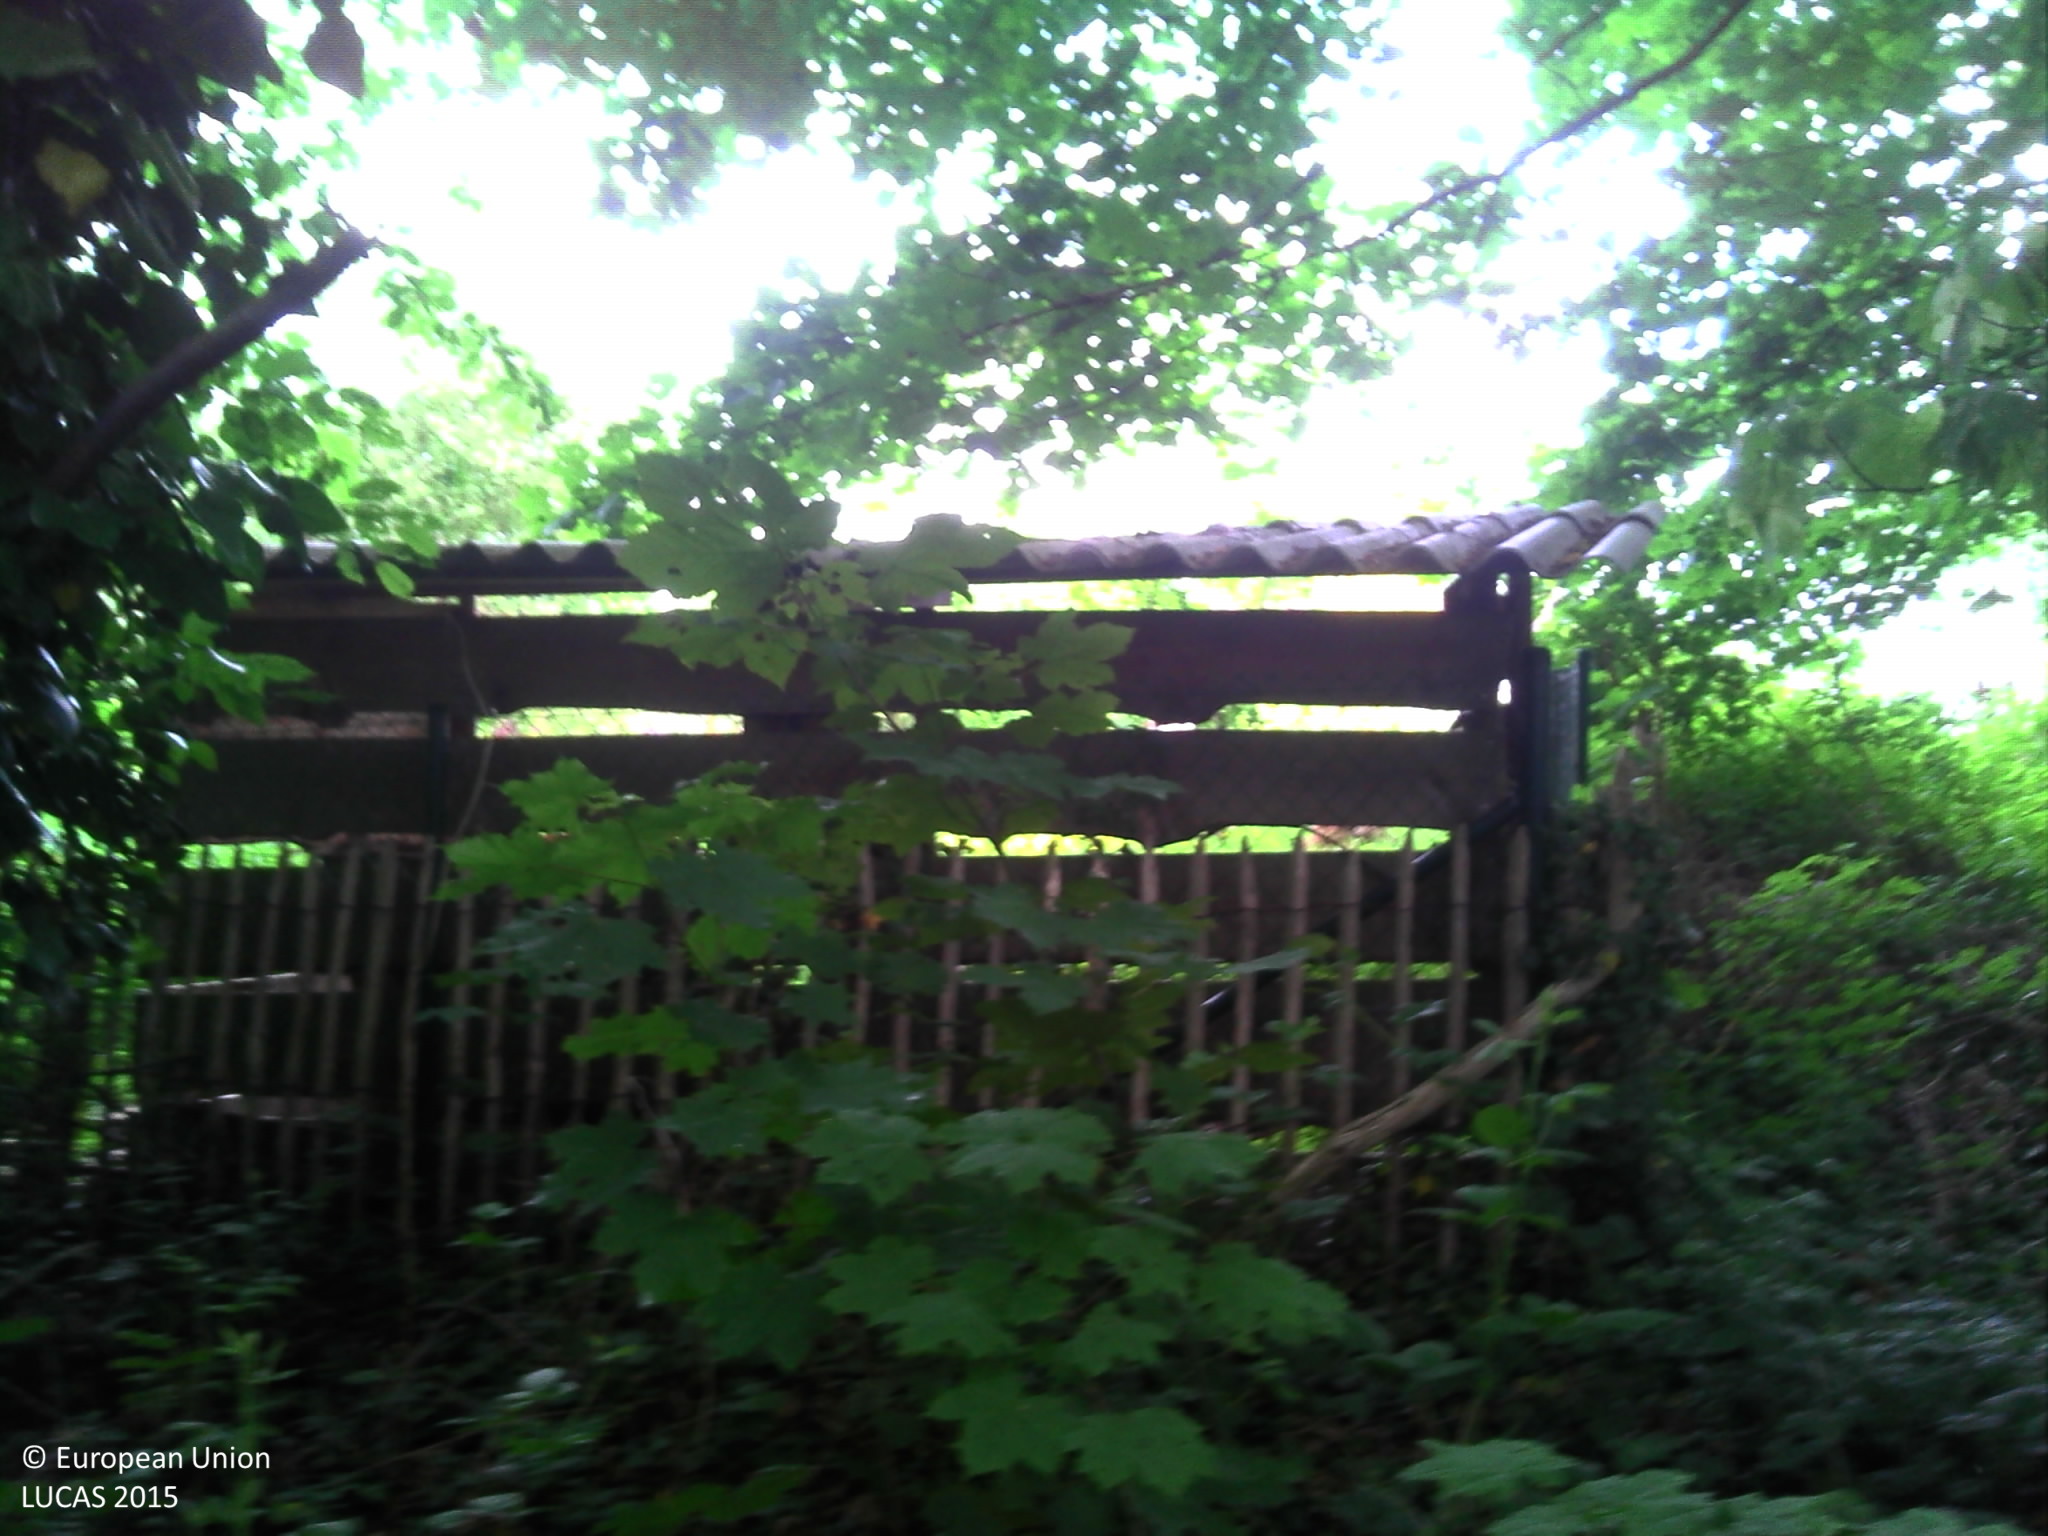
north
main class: Woodland
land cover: Broadleaved woodland
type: beech forest
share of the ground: > 75 %
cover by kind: broadleaved forest trees 100 %
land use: Forestry
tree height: > 5 m
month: May
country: BE
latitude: 50.6819
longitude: 4.4903
